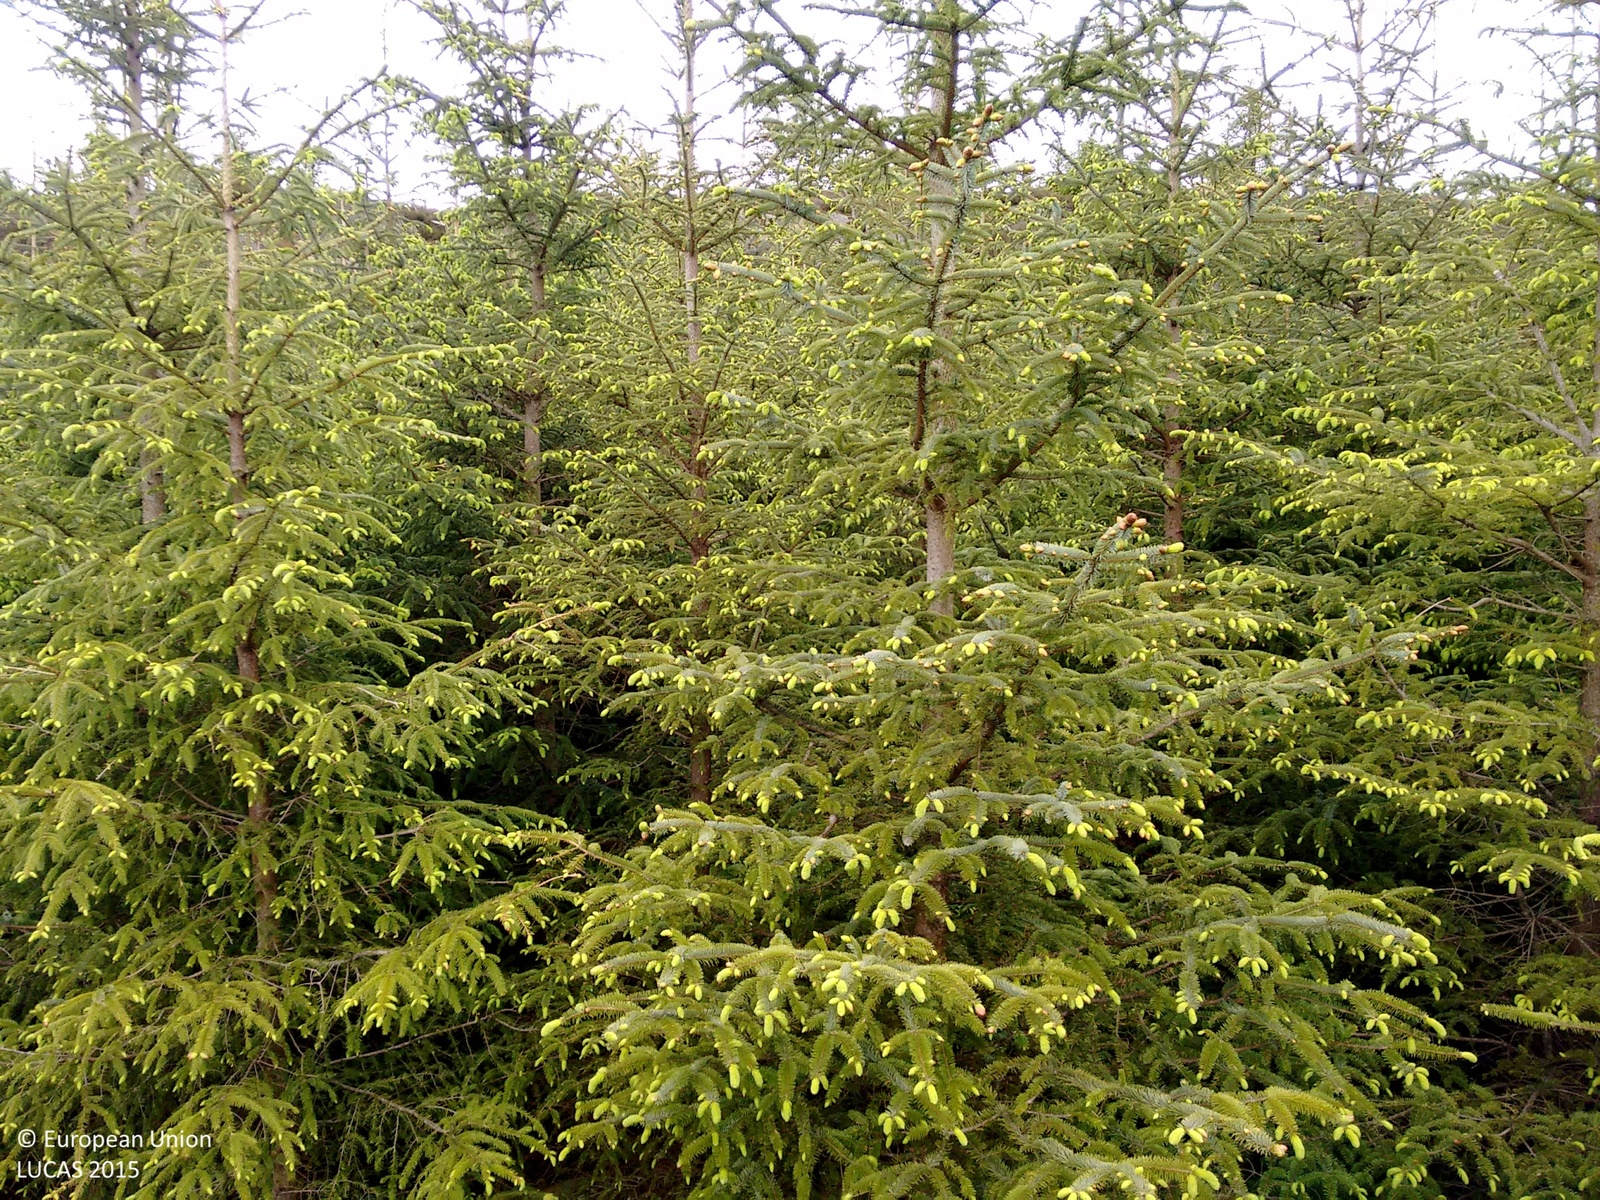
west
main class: Woodland
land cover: Spruce dominated coniferous woodland
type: exotic forest
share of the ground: > 75 %
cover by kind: coniferous forest trees 100 %
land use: Forestry
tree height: > 5 m
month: June
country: GB
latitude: 56.1205
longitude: -5.4825
